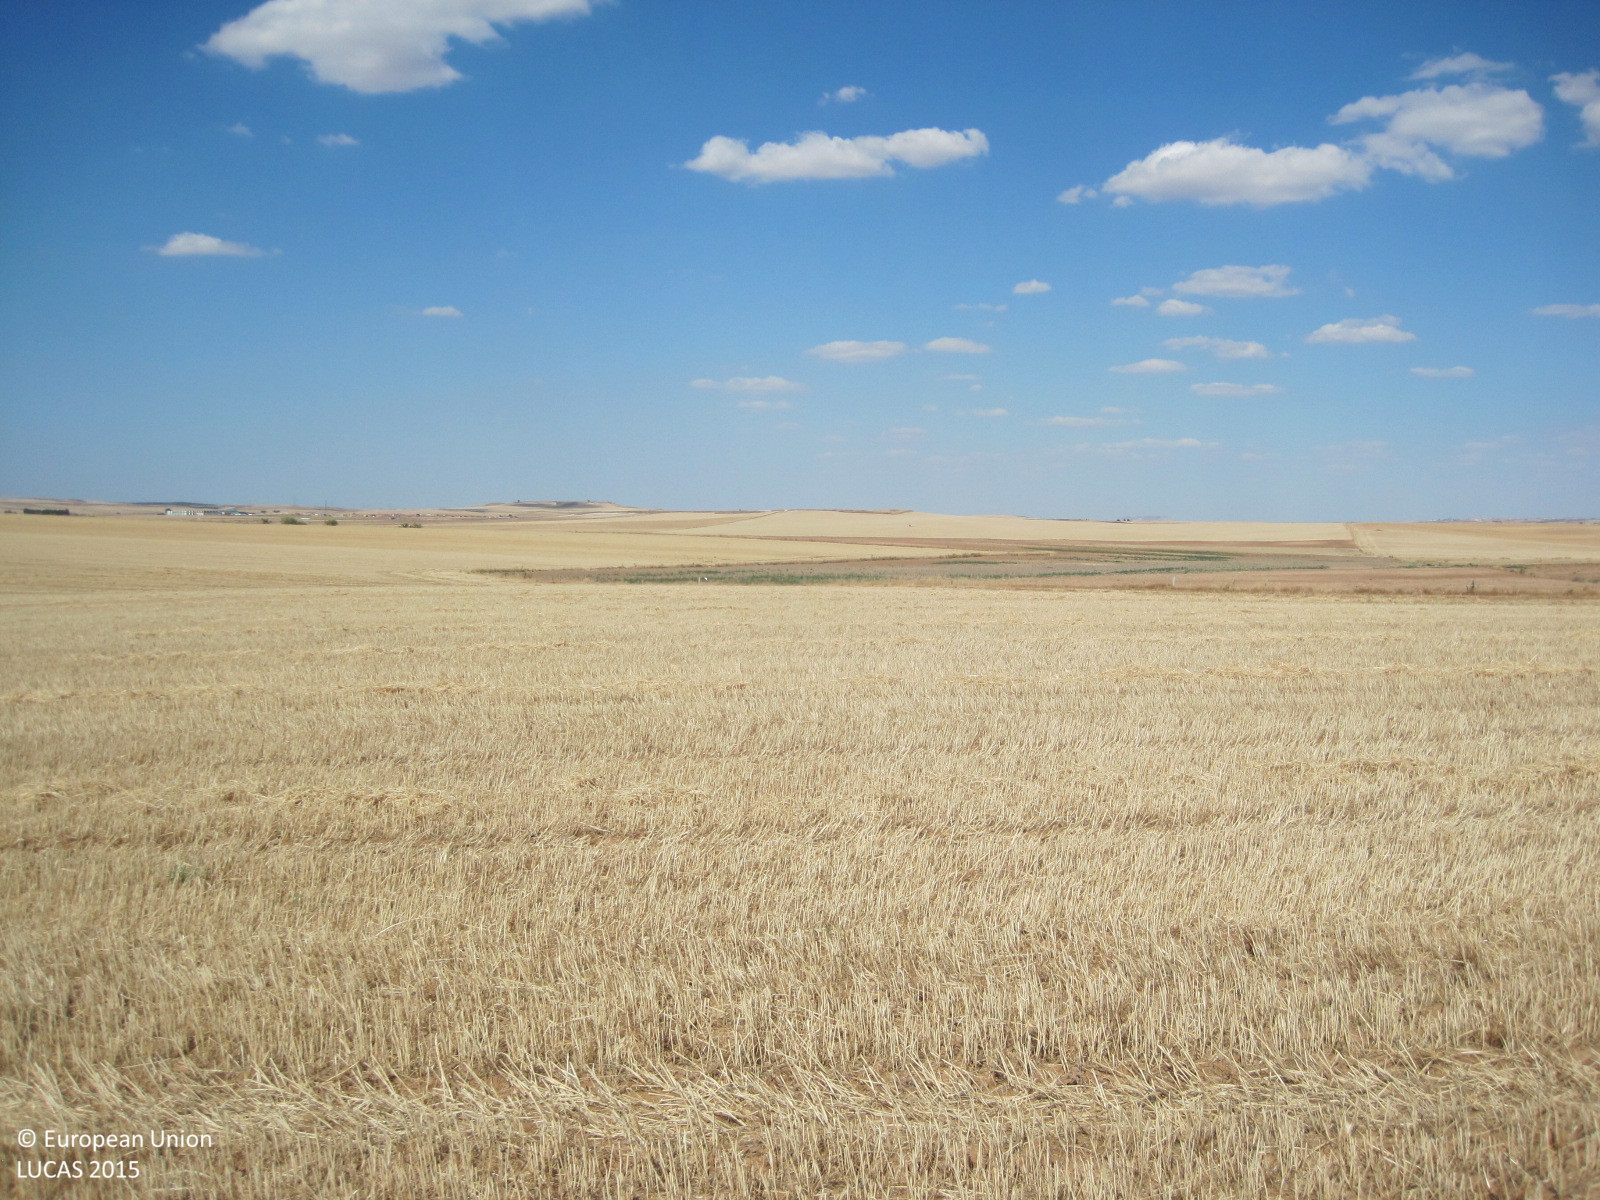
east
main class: Cropland
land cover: Barley
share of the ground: < 10 %
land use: Agriculture (excluding fallow land and kitchen gardens)
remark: Harvested field
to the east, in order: Barley; Grass margins; Other bare soil
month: June
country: ES
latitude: 39.9389
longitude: -4.2340
